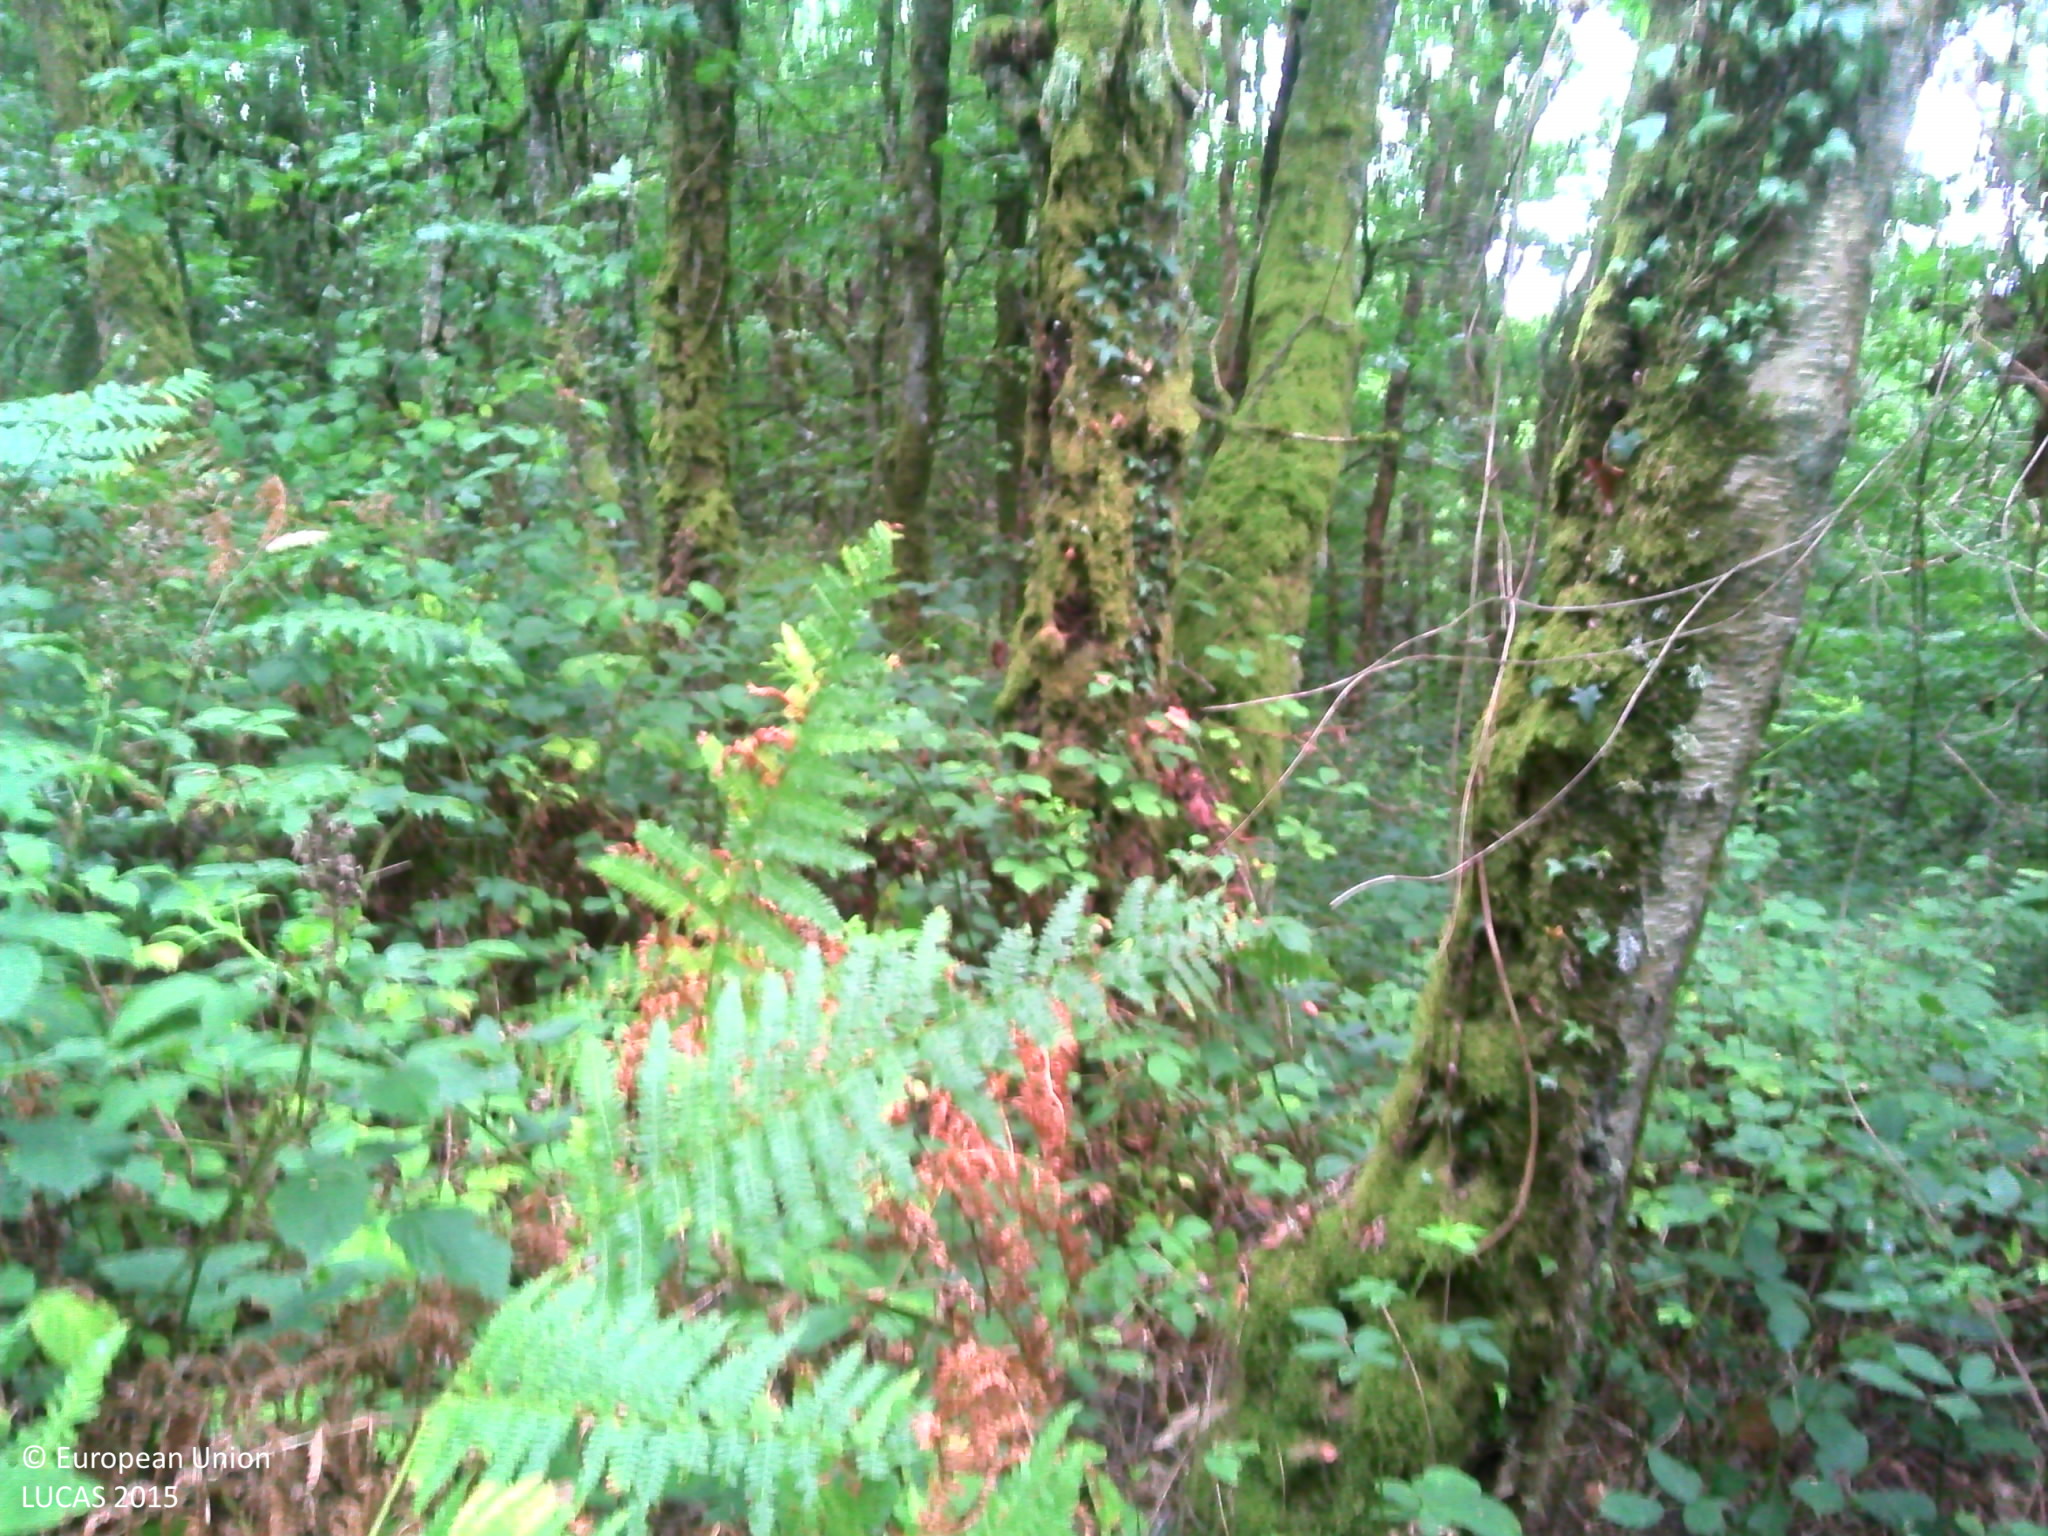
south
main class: Woodland
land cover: Broadleaved woodland
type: mesophytic deciduous forest
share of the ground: > 75 %
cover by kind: broadleaved forest trees 85 %, herbaceous plants 15 %
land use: Forestry
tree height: > 5 m
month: August
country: FR
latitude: 46.0404
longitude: 1.3978
